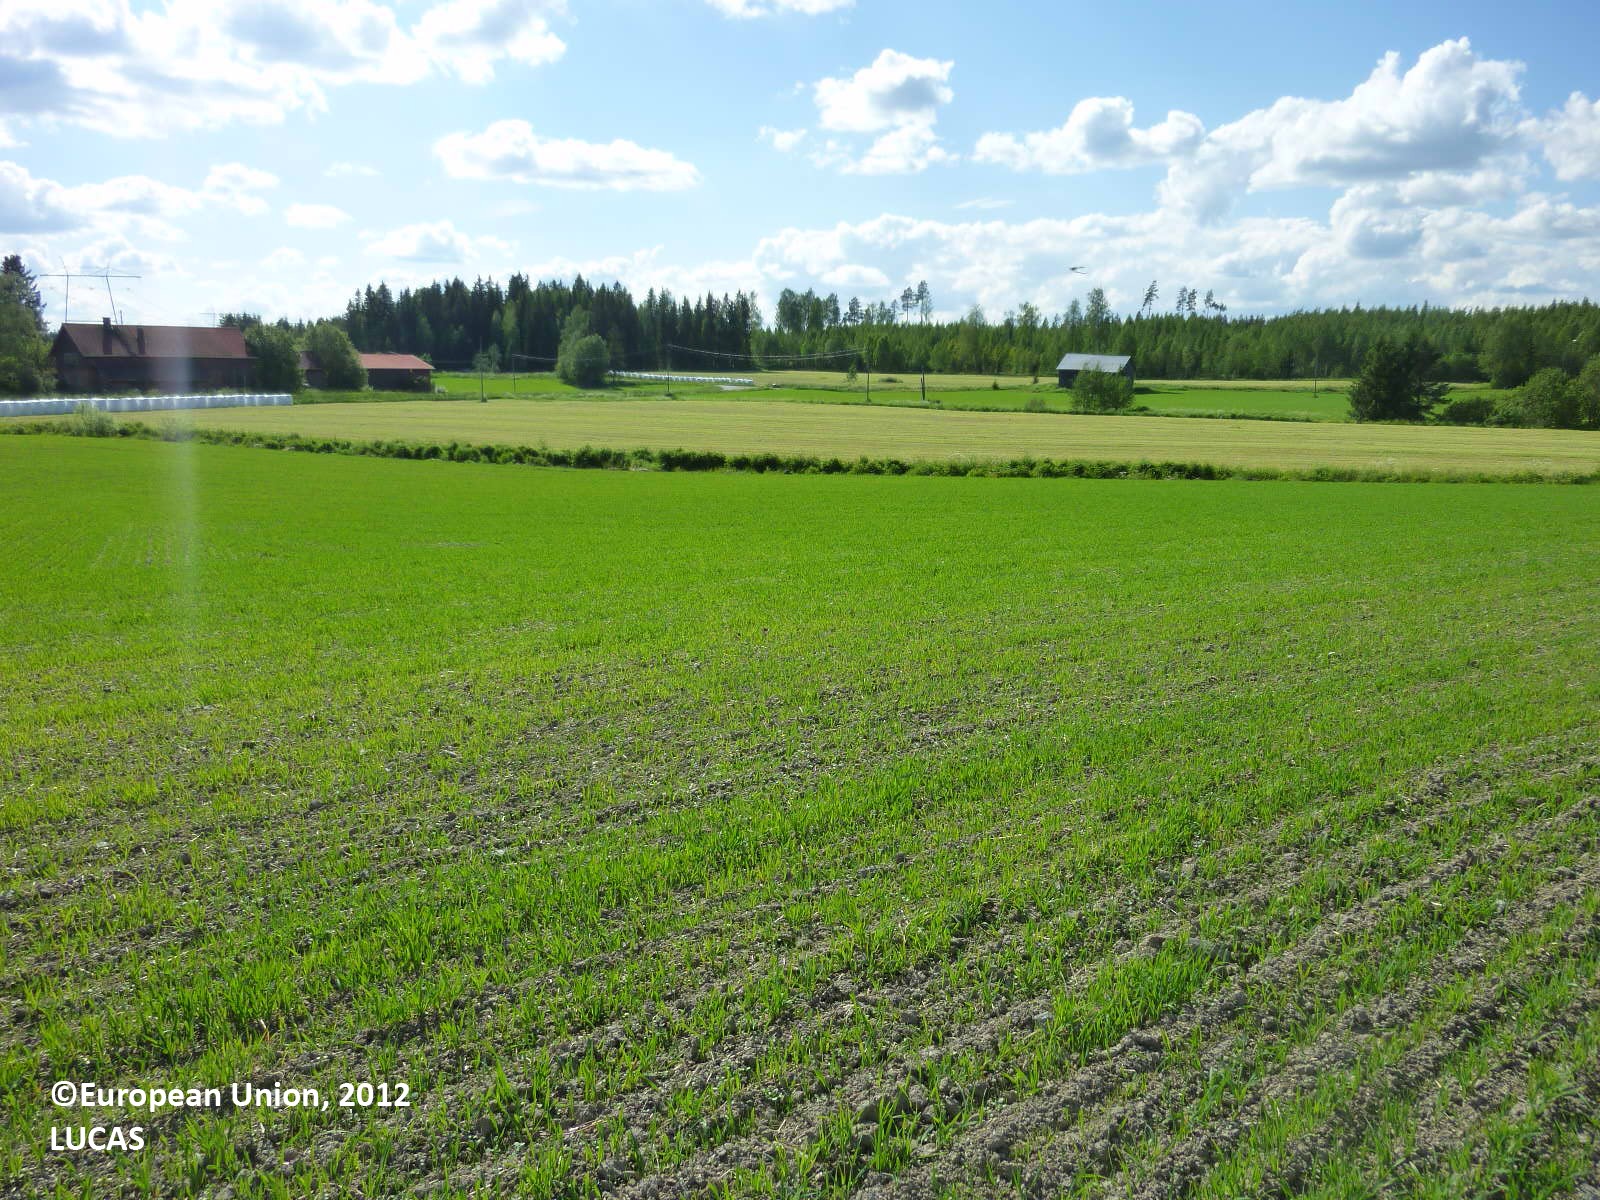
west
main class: Cropland
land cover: Oats
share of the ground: > 75 %
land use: Agriculture (excluding fallow land and kitchen gardens)
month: June
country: FI
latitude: 61.4233
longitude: 22.7933
